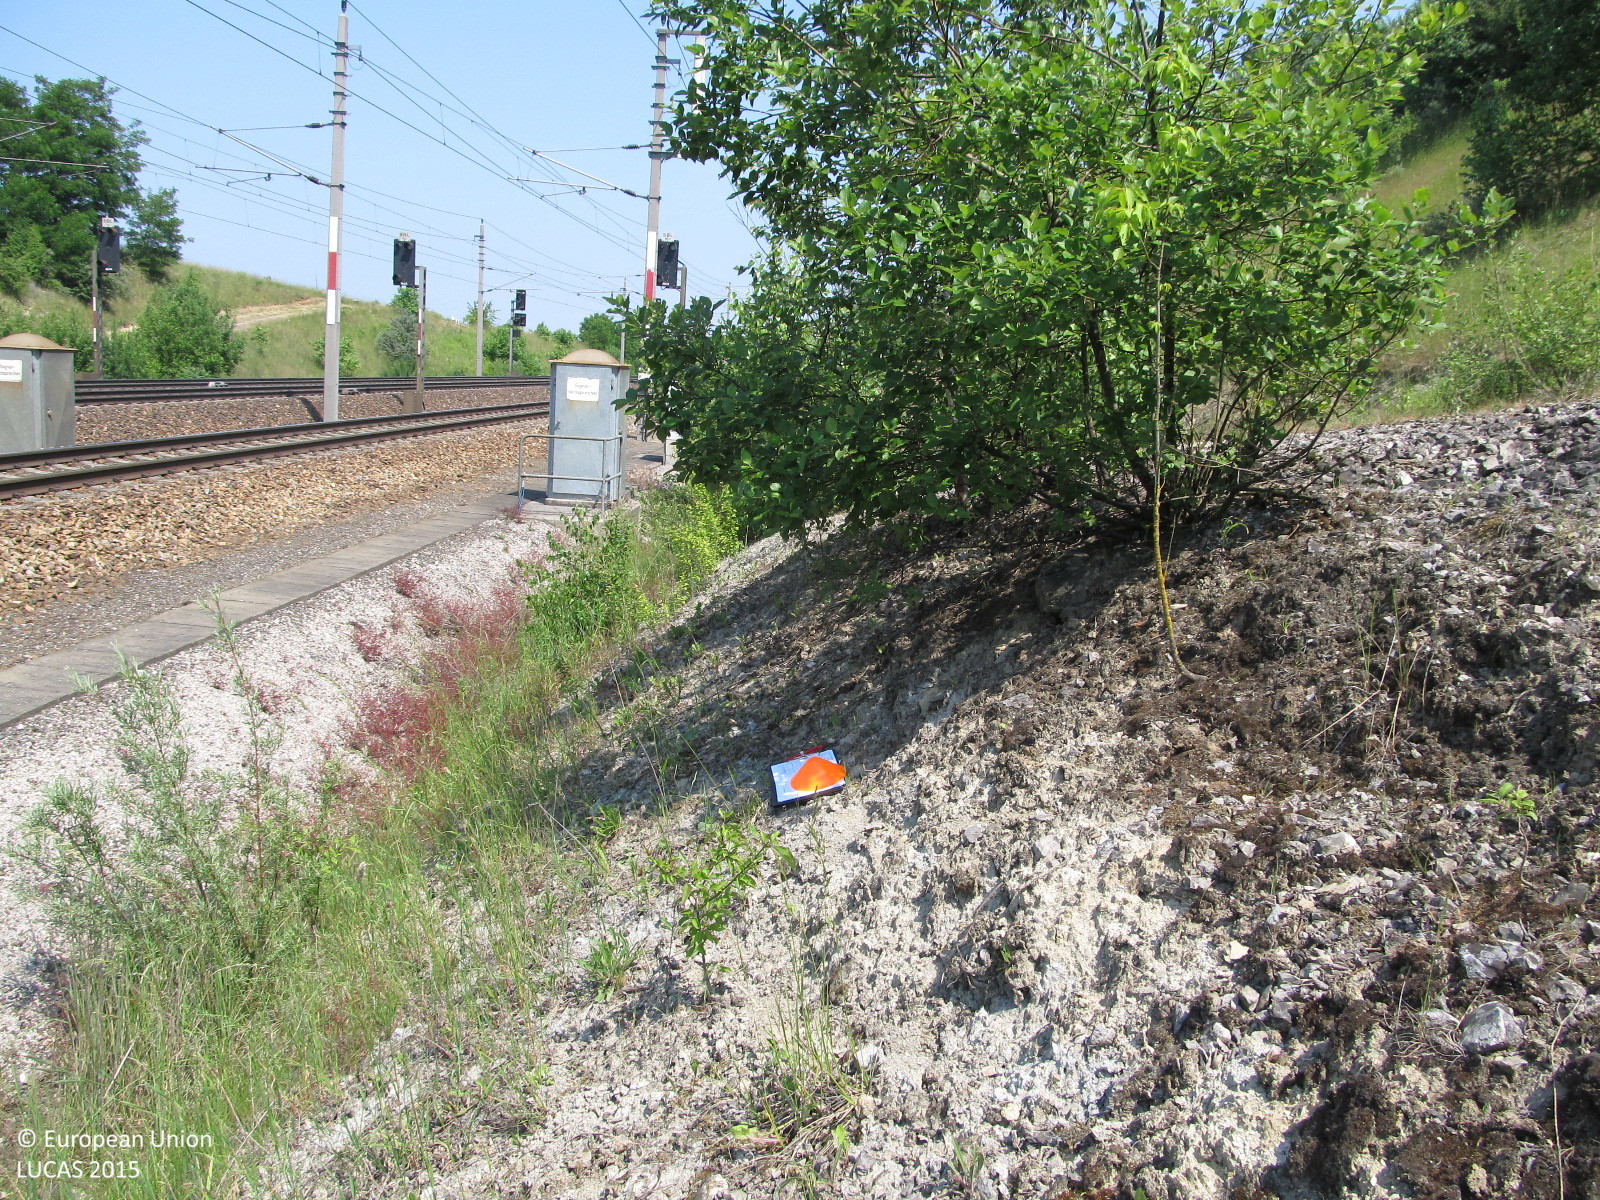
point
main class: Grassland
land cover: Spontaneously vegetated surfaces
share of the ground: > 75 %
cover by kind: unconsolidated bare surface 50 %, herbaceous plants 25 %, consolidated bare surface 20 %, shrubs 5 %
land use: Railway transport
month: June
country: AT
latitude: 48.2095
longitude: 15.5602
